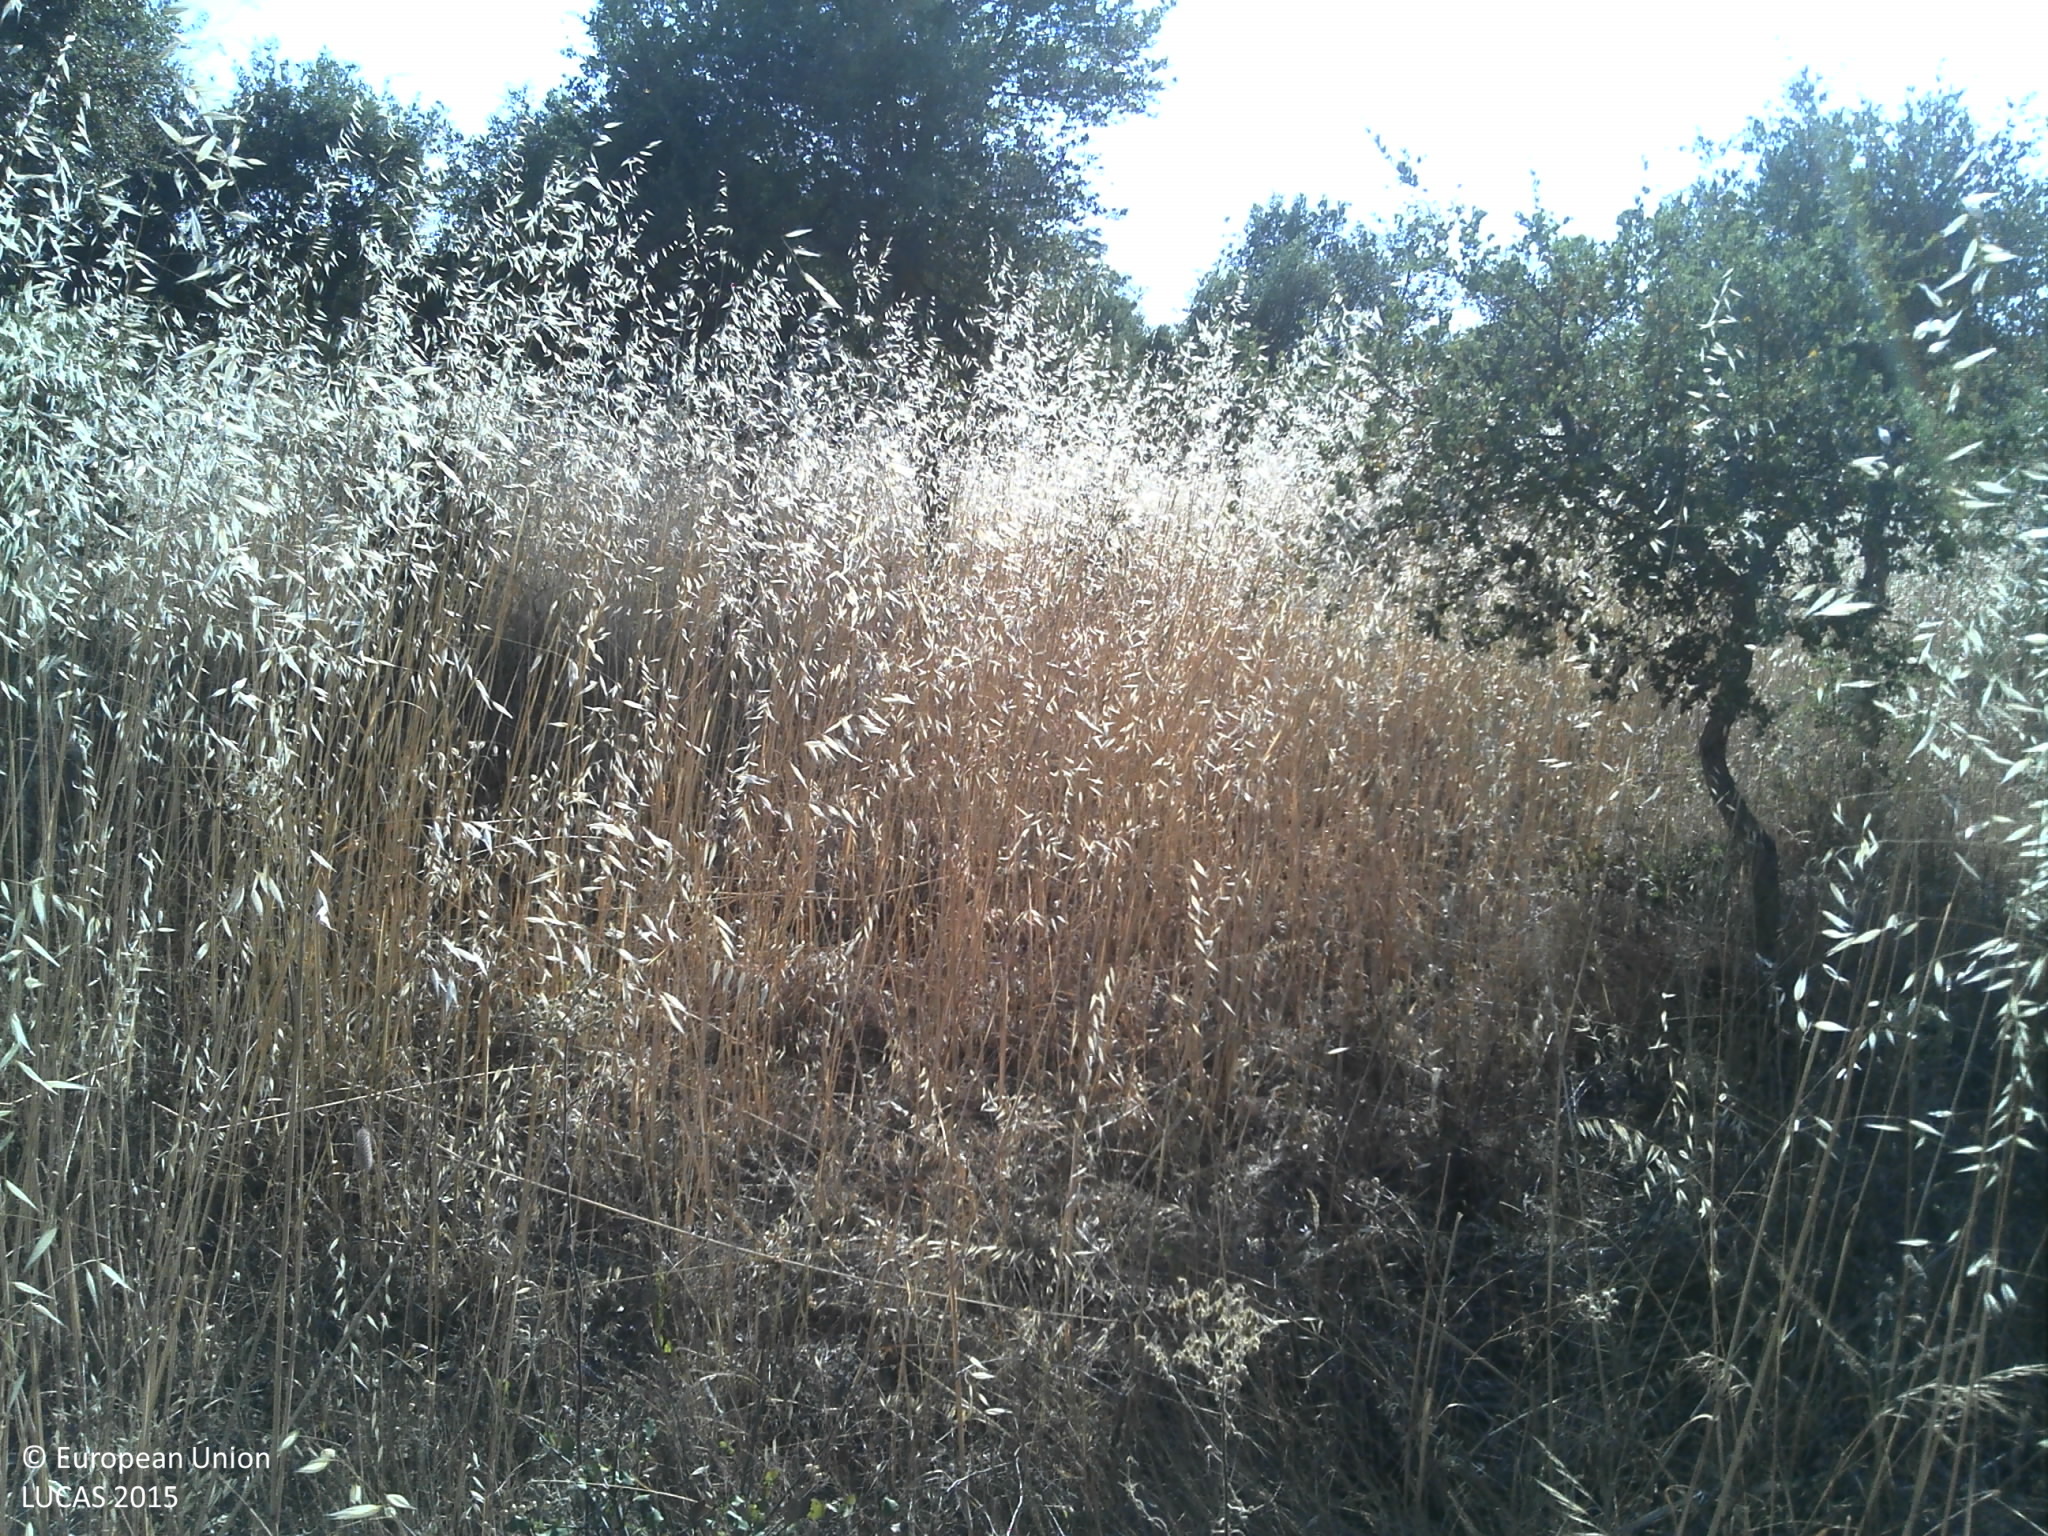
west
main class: Woodland
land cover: Broadleaved woodland
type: broadleaved evergreen forest
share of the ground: < 10 %
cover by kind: herbaceous plants 90 %, broadleaved forest trees 10 %
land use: Forestry
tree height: > 5 m
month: June
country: PT
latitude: 40.8244
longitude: -6.8547
